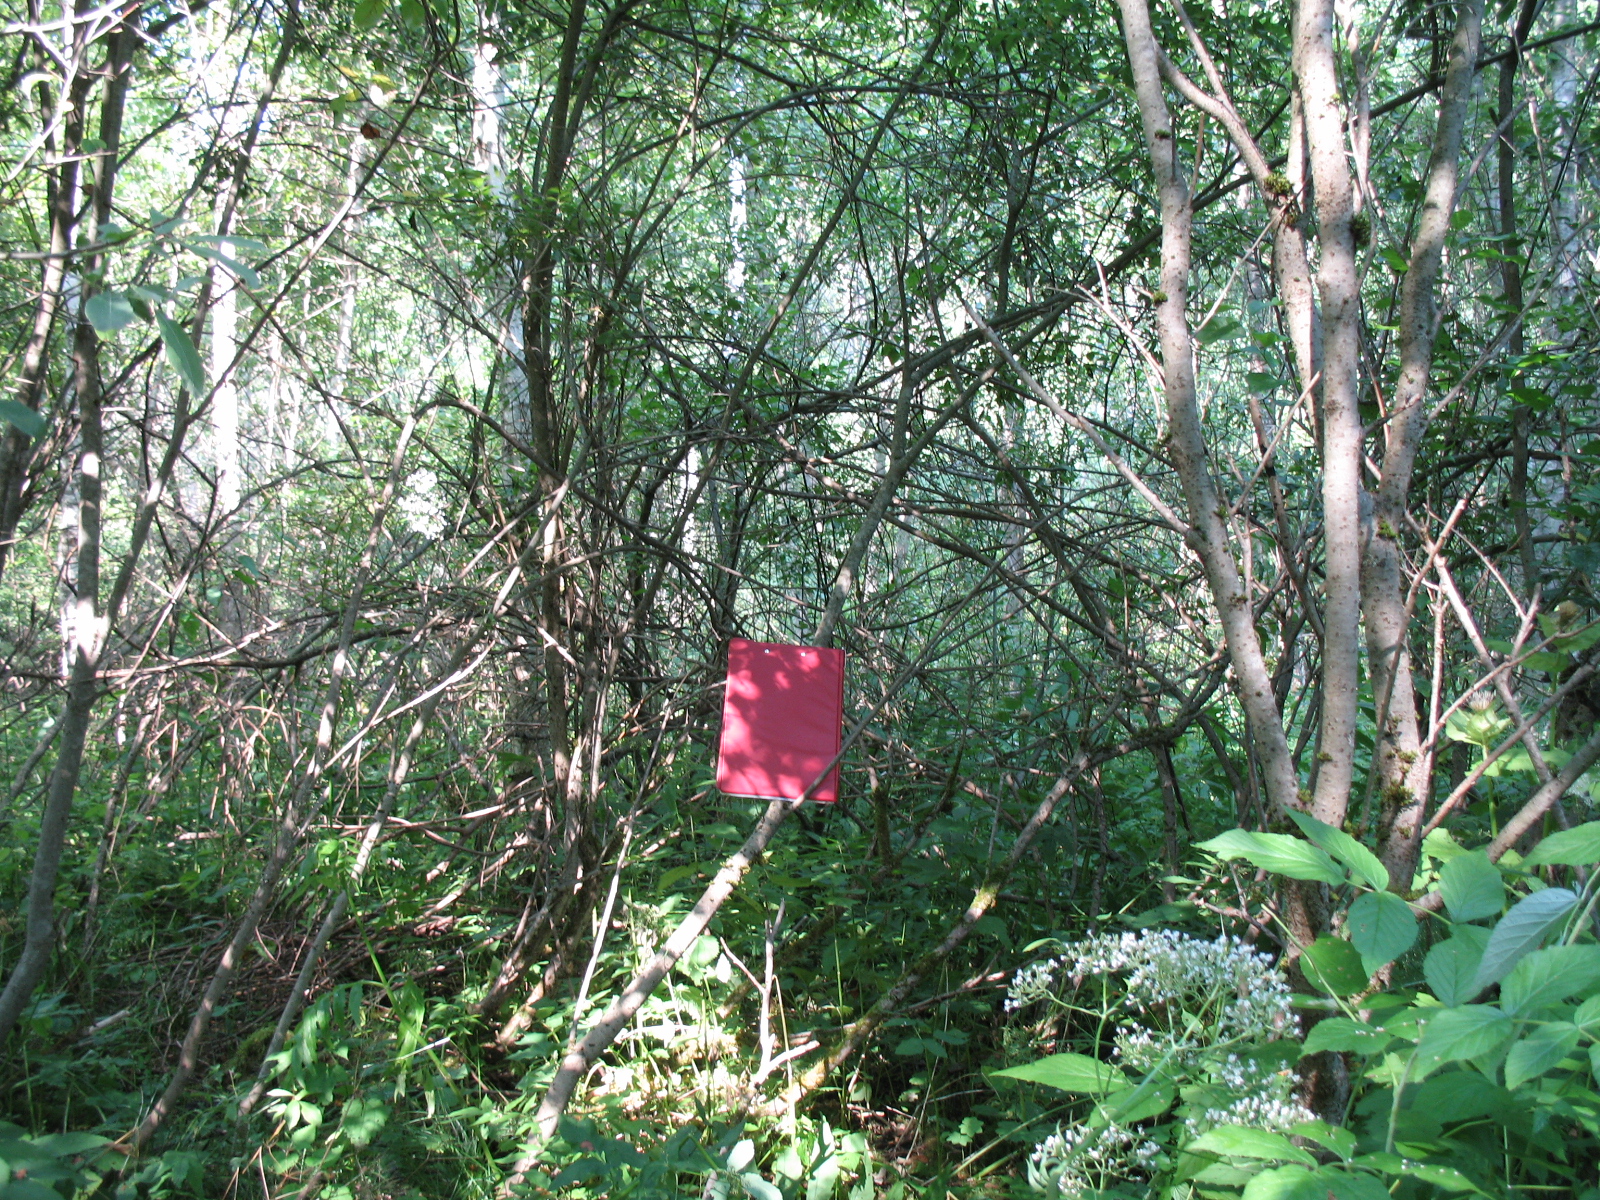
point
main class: Woodland
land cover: Broadleaved woodland
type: non-riverine alder, birch or aspen forest
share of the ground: > 75 %
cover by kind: broadleaved forest trees 85 %, shrubs 10 %, herbaceous plants 5 %
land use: Forestry
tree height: > 5 m
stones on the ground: < 10 %
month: August
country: LV
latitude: 56.4779
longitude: 25.5622
